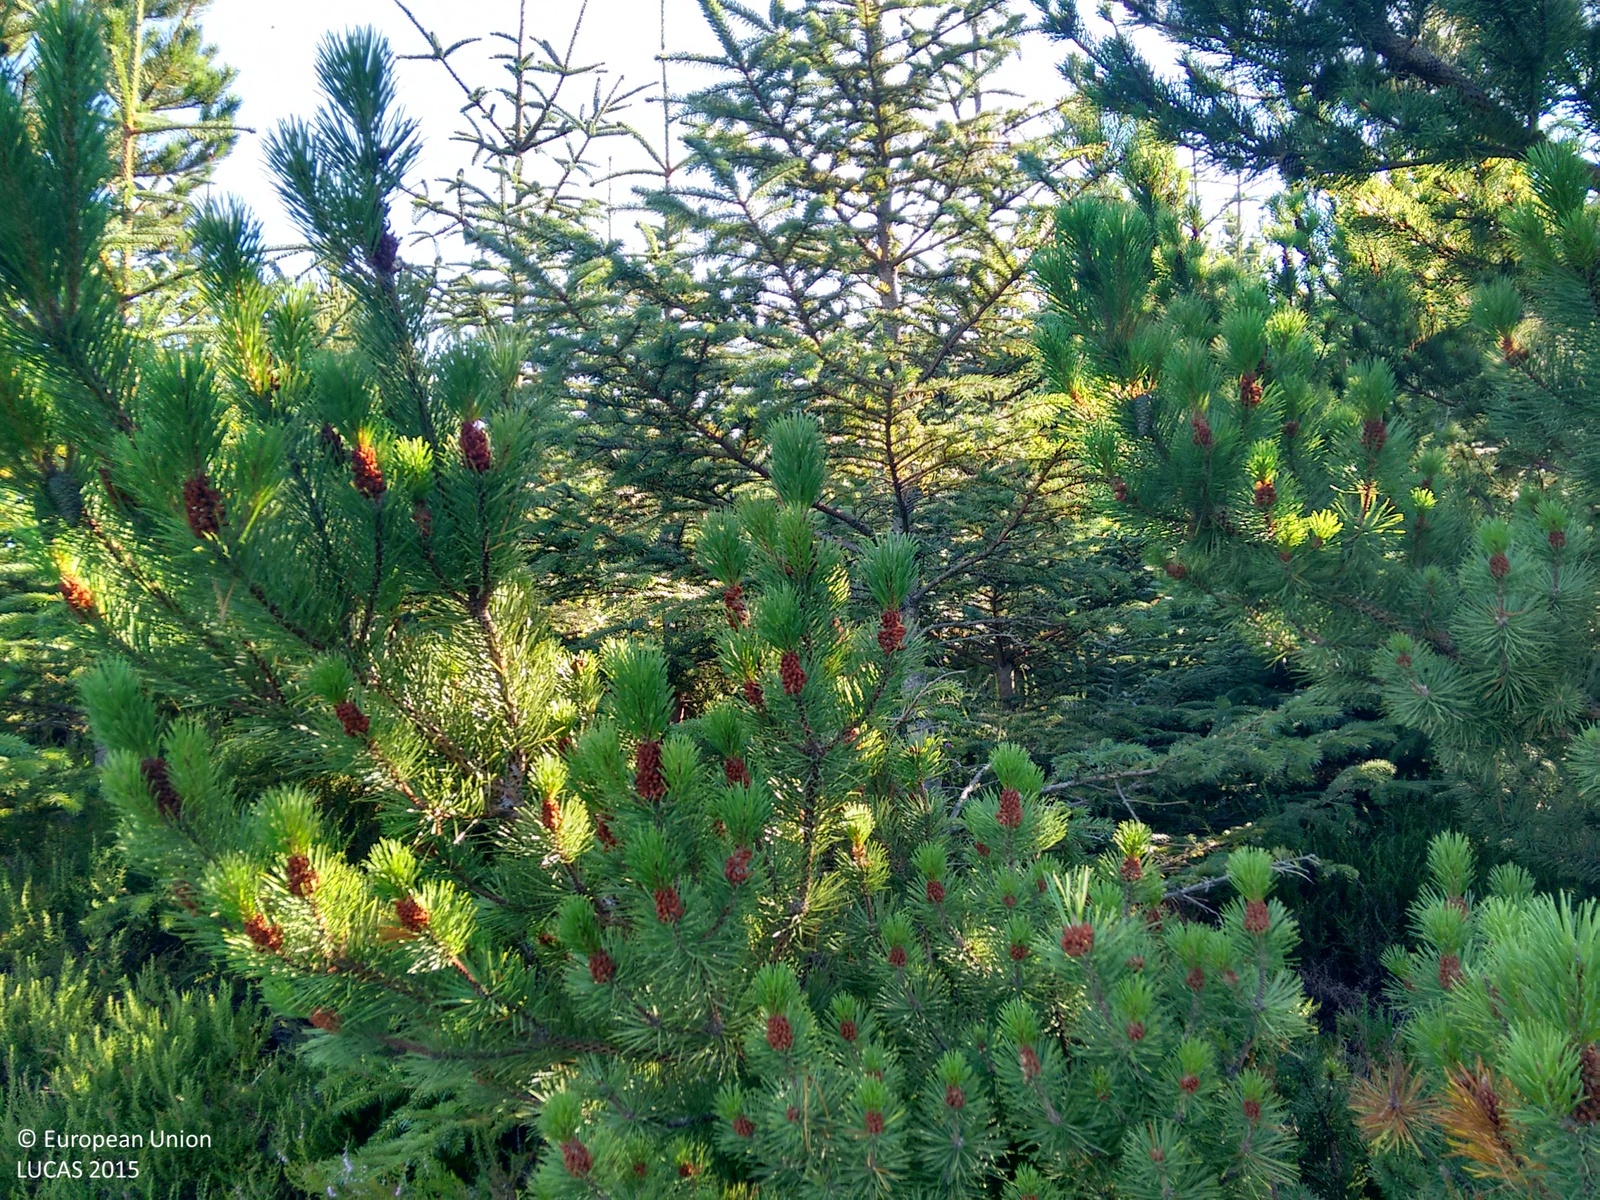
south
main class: Woodland
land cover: Spruce dominated coniferous woodland
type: exotic forest
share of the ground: > 75 %
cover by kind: coniferous forest trees 95 %, shrubs 5 %
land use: Forestry
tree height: > 5 m
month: September
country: GB
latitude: 58.4790
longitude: -4.2622
